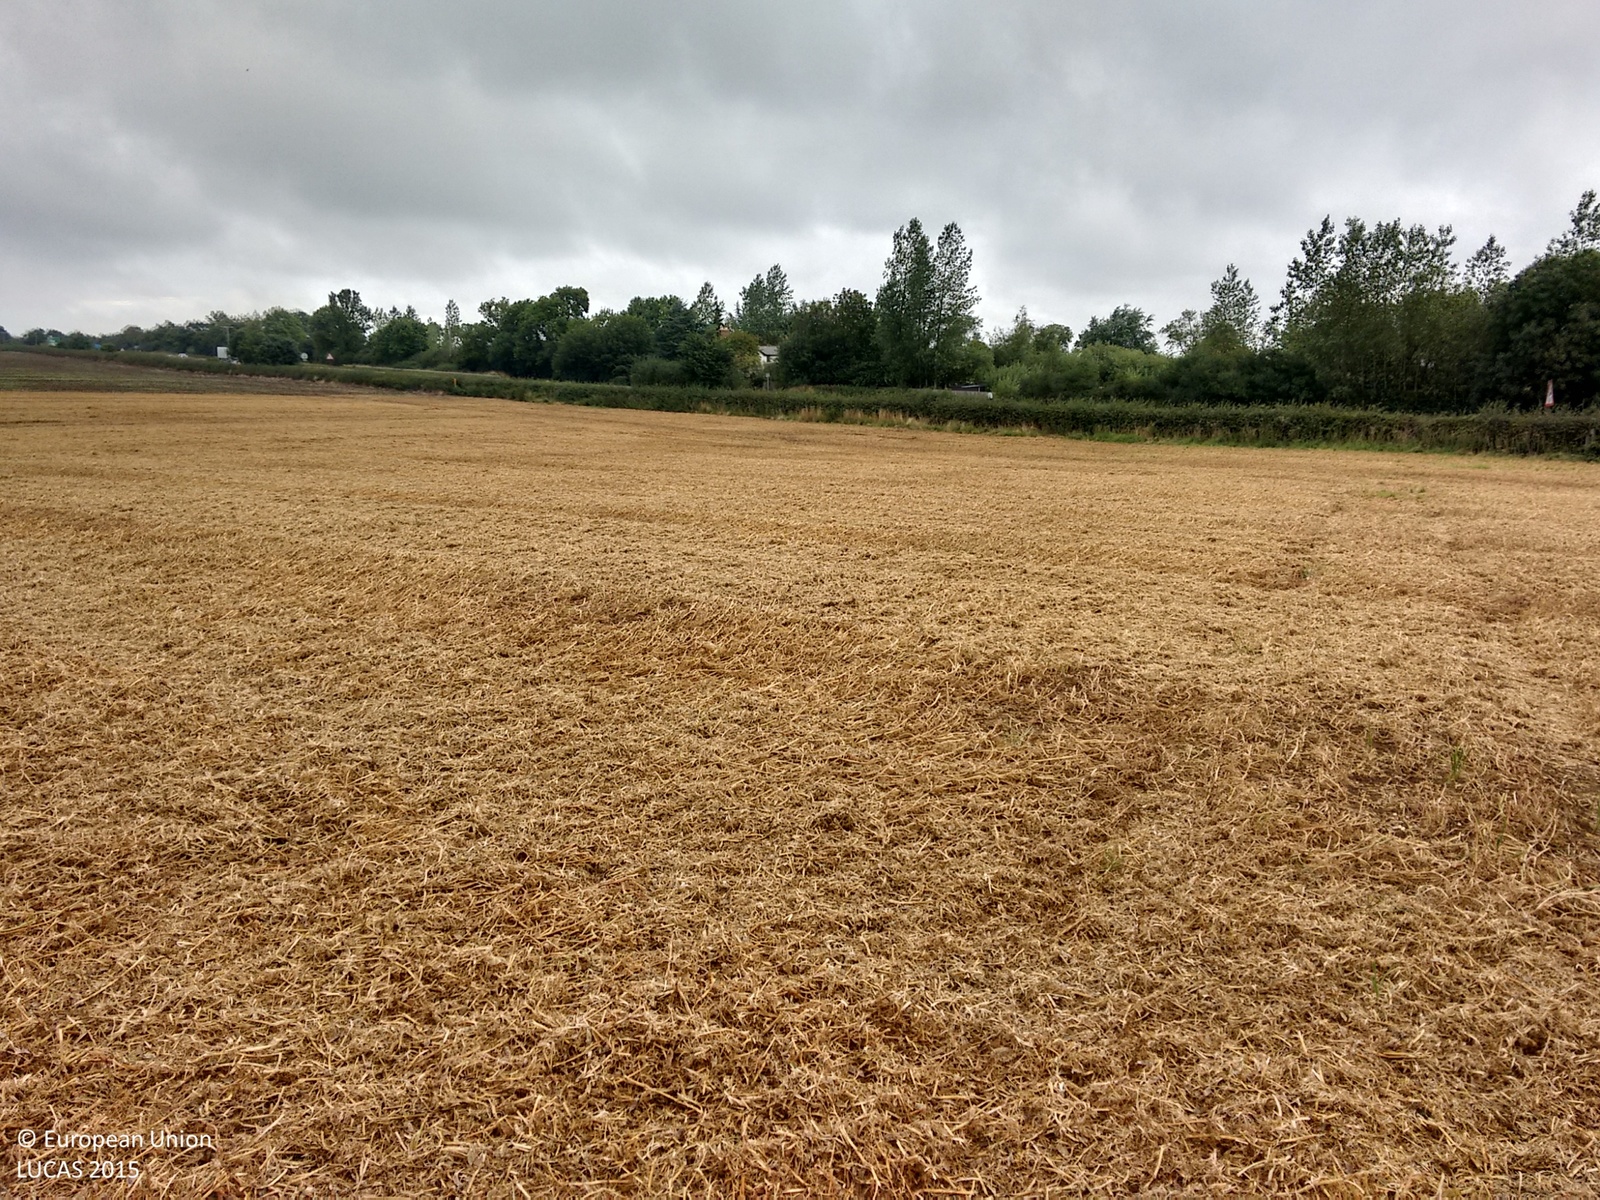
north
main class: Cropland
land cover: Dry pulses
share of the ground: > 75 %
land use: Agriculture (excluding fallow land and kitchen gardens)
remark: Harvested field
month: September
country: GB
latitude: 52.4734
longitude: -1.2807
